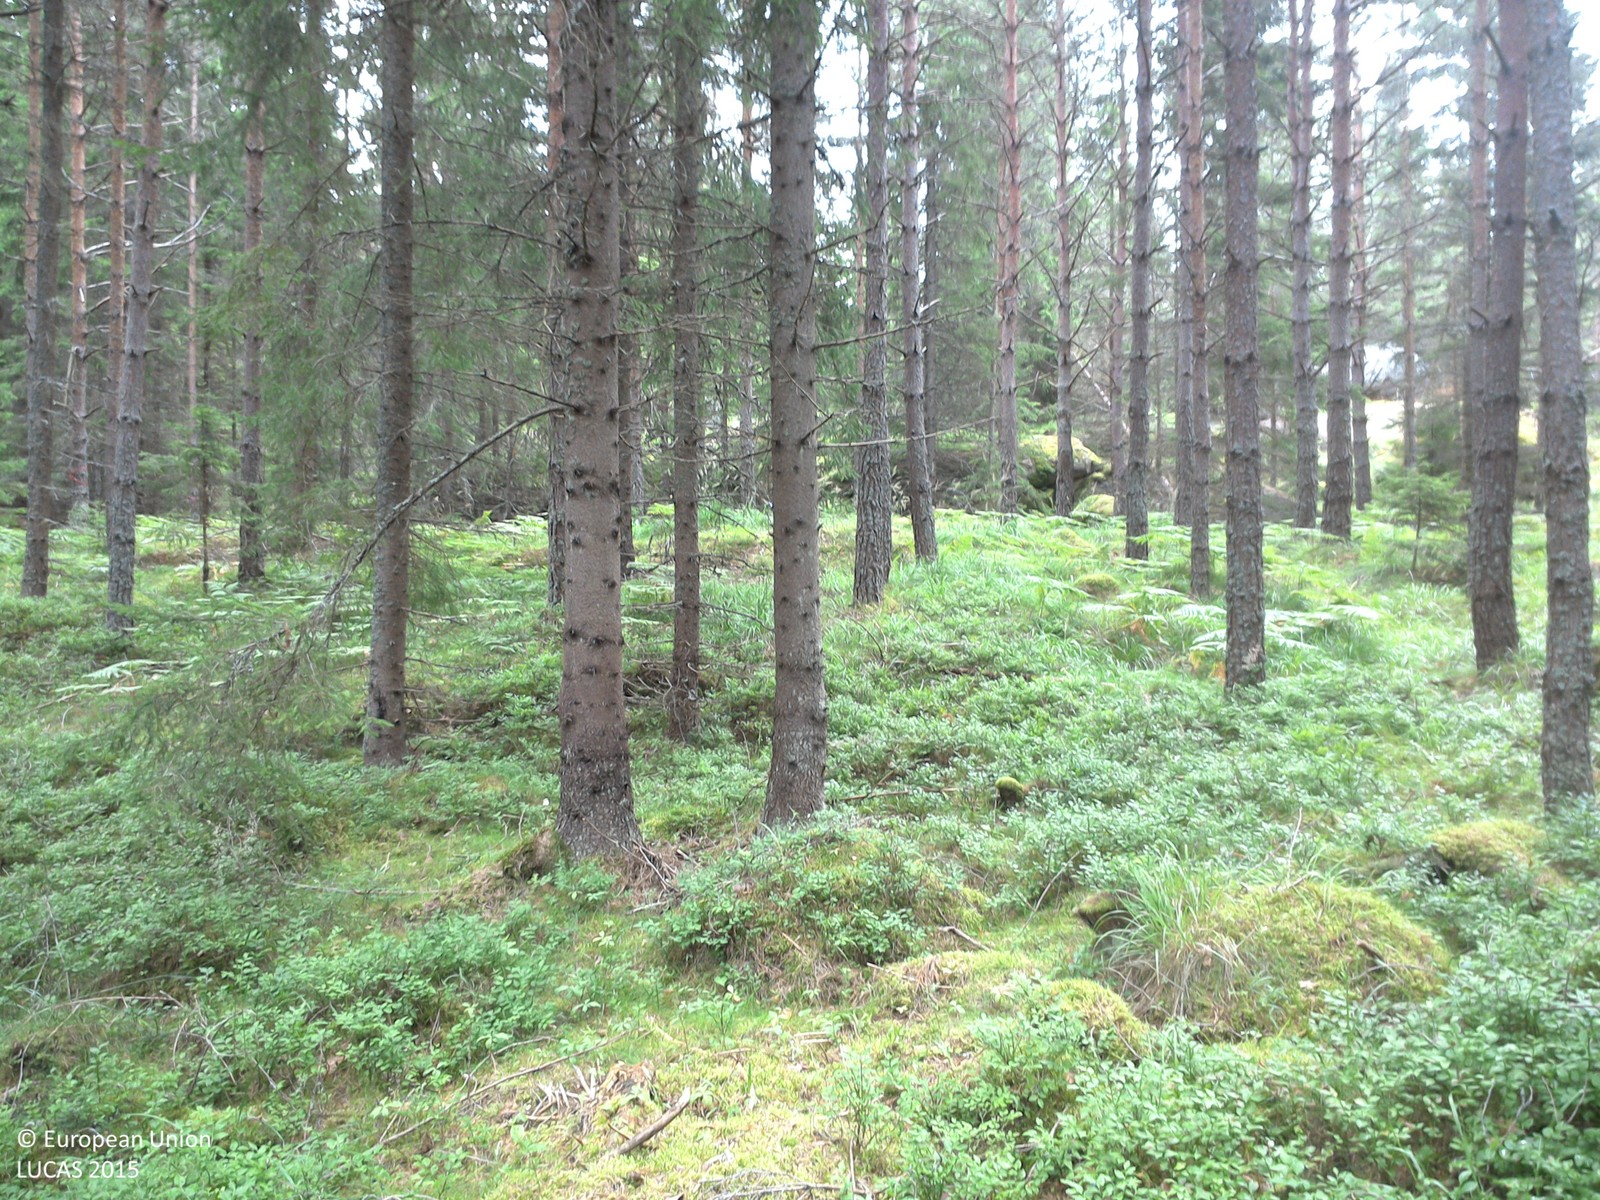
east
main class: Woodland
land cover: Pine dominated coniferous woodland
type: boreal forest
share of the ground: 50 - 75 %
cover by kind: coniferous forest trees 60 %, herbaceous plants 30 %, lichens and mosses 10 %
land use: Forestry
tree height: > 5 m
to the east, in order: Pine dominated coniferous woodland; Lichens and moss; Spruce dominated coniferous woodland; Spruce dominated mixed woodland; Spruce dominated coniferous woodland
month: July
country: SE
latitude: 57.8684
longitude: 16.0149
